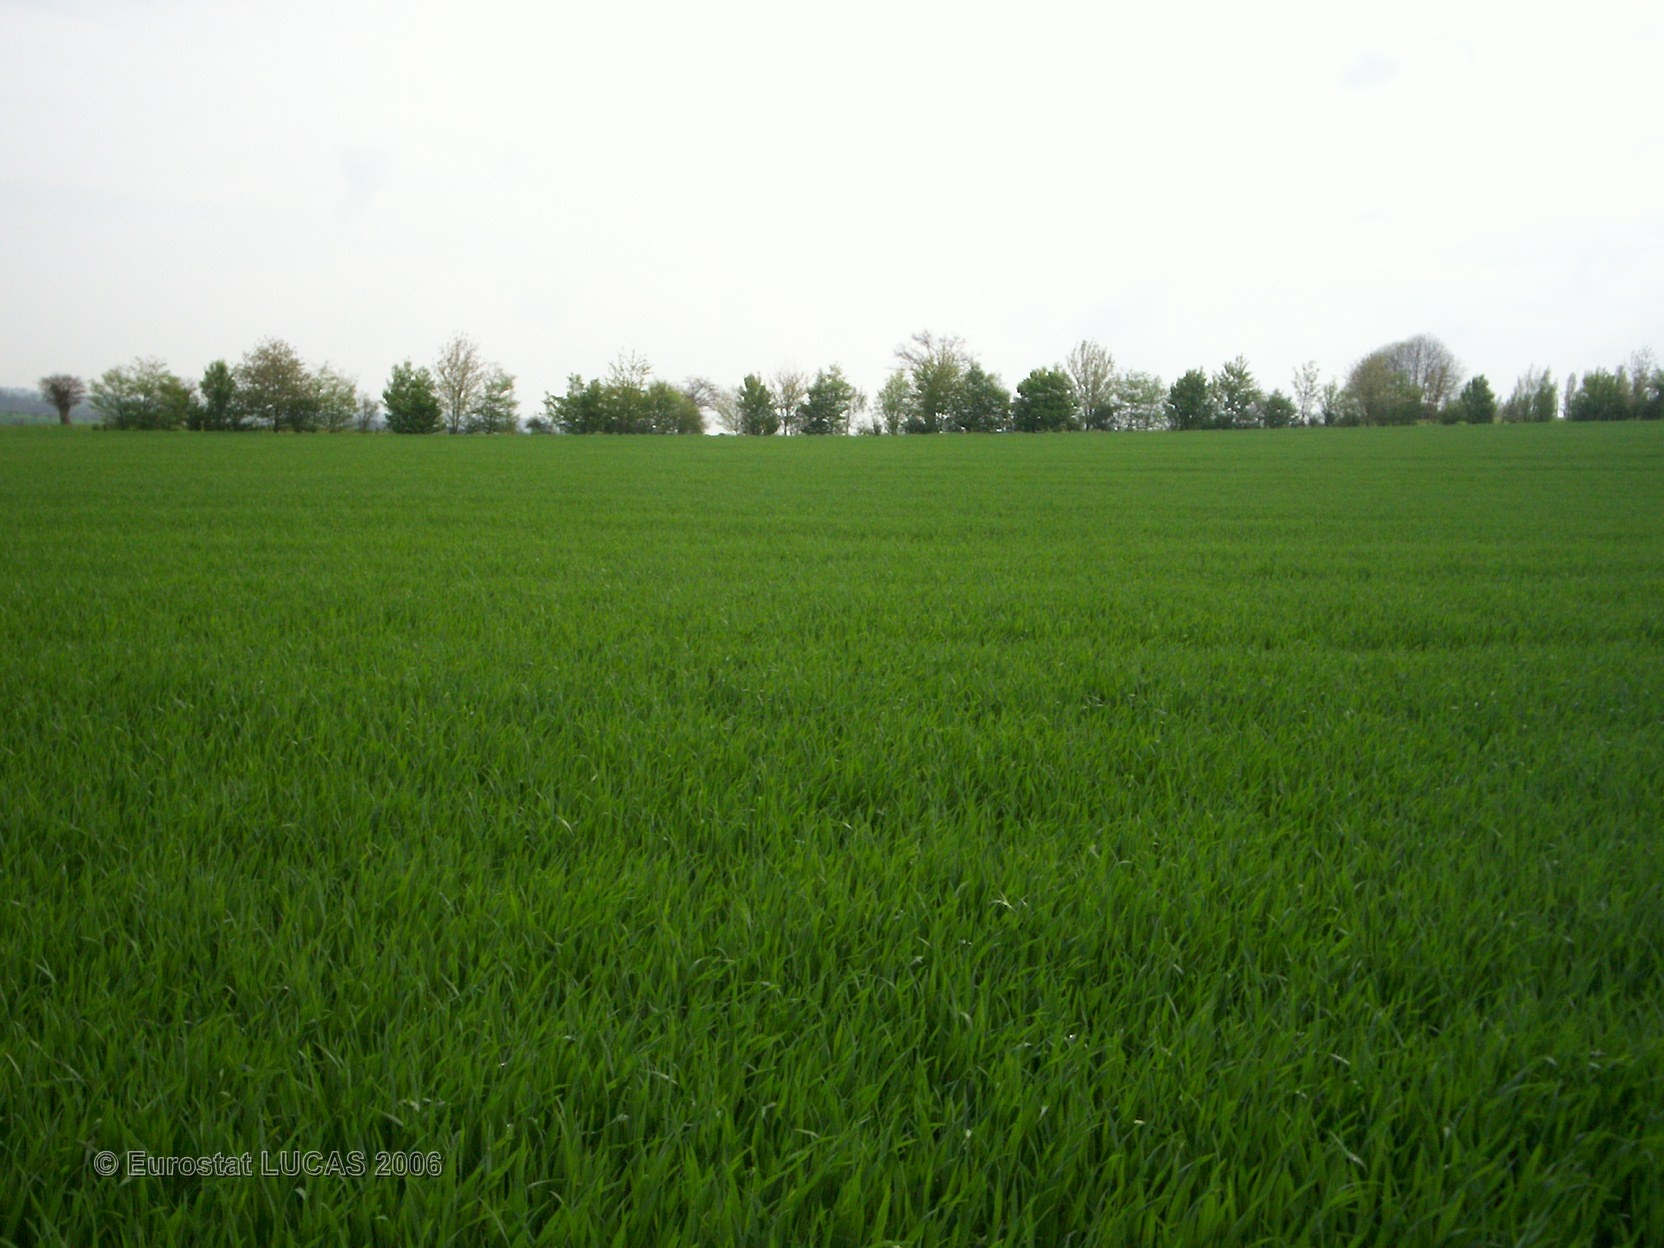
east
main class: Cropland
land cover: Common wheat
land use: Agriculture (excluding fallow land and kitchen gardens)
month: April
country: FR
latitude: 47.8326
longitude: -1.5476
